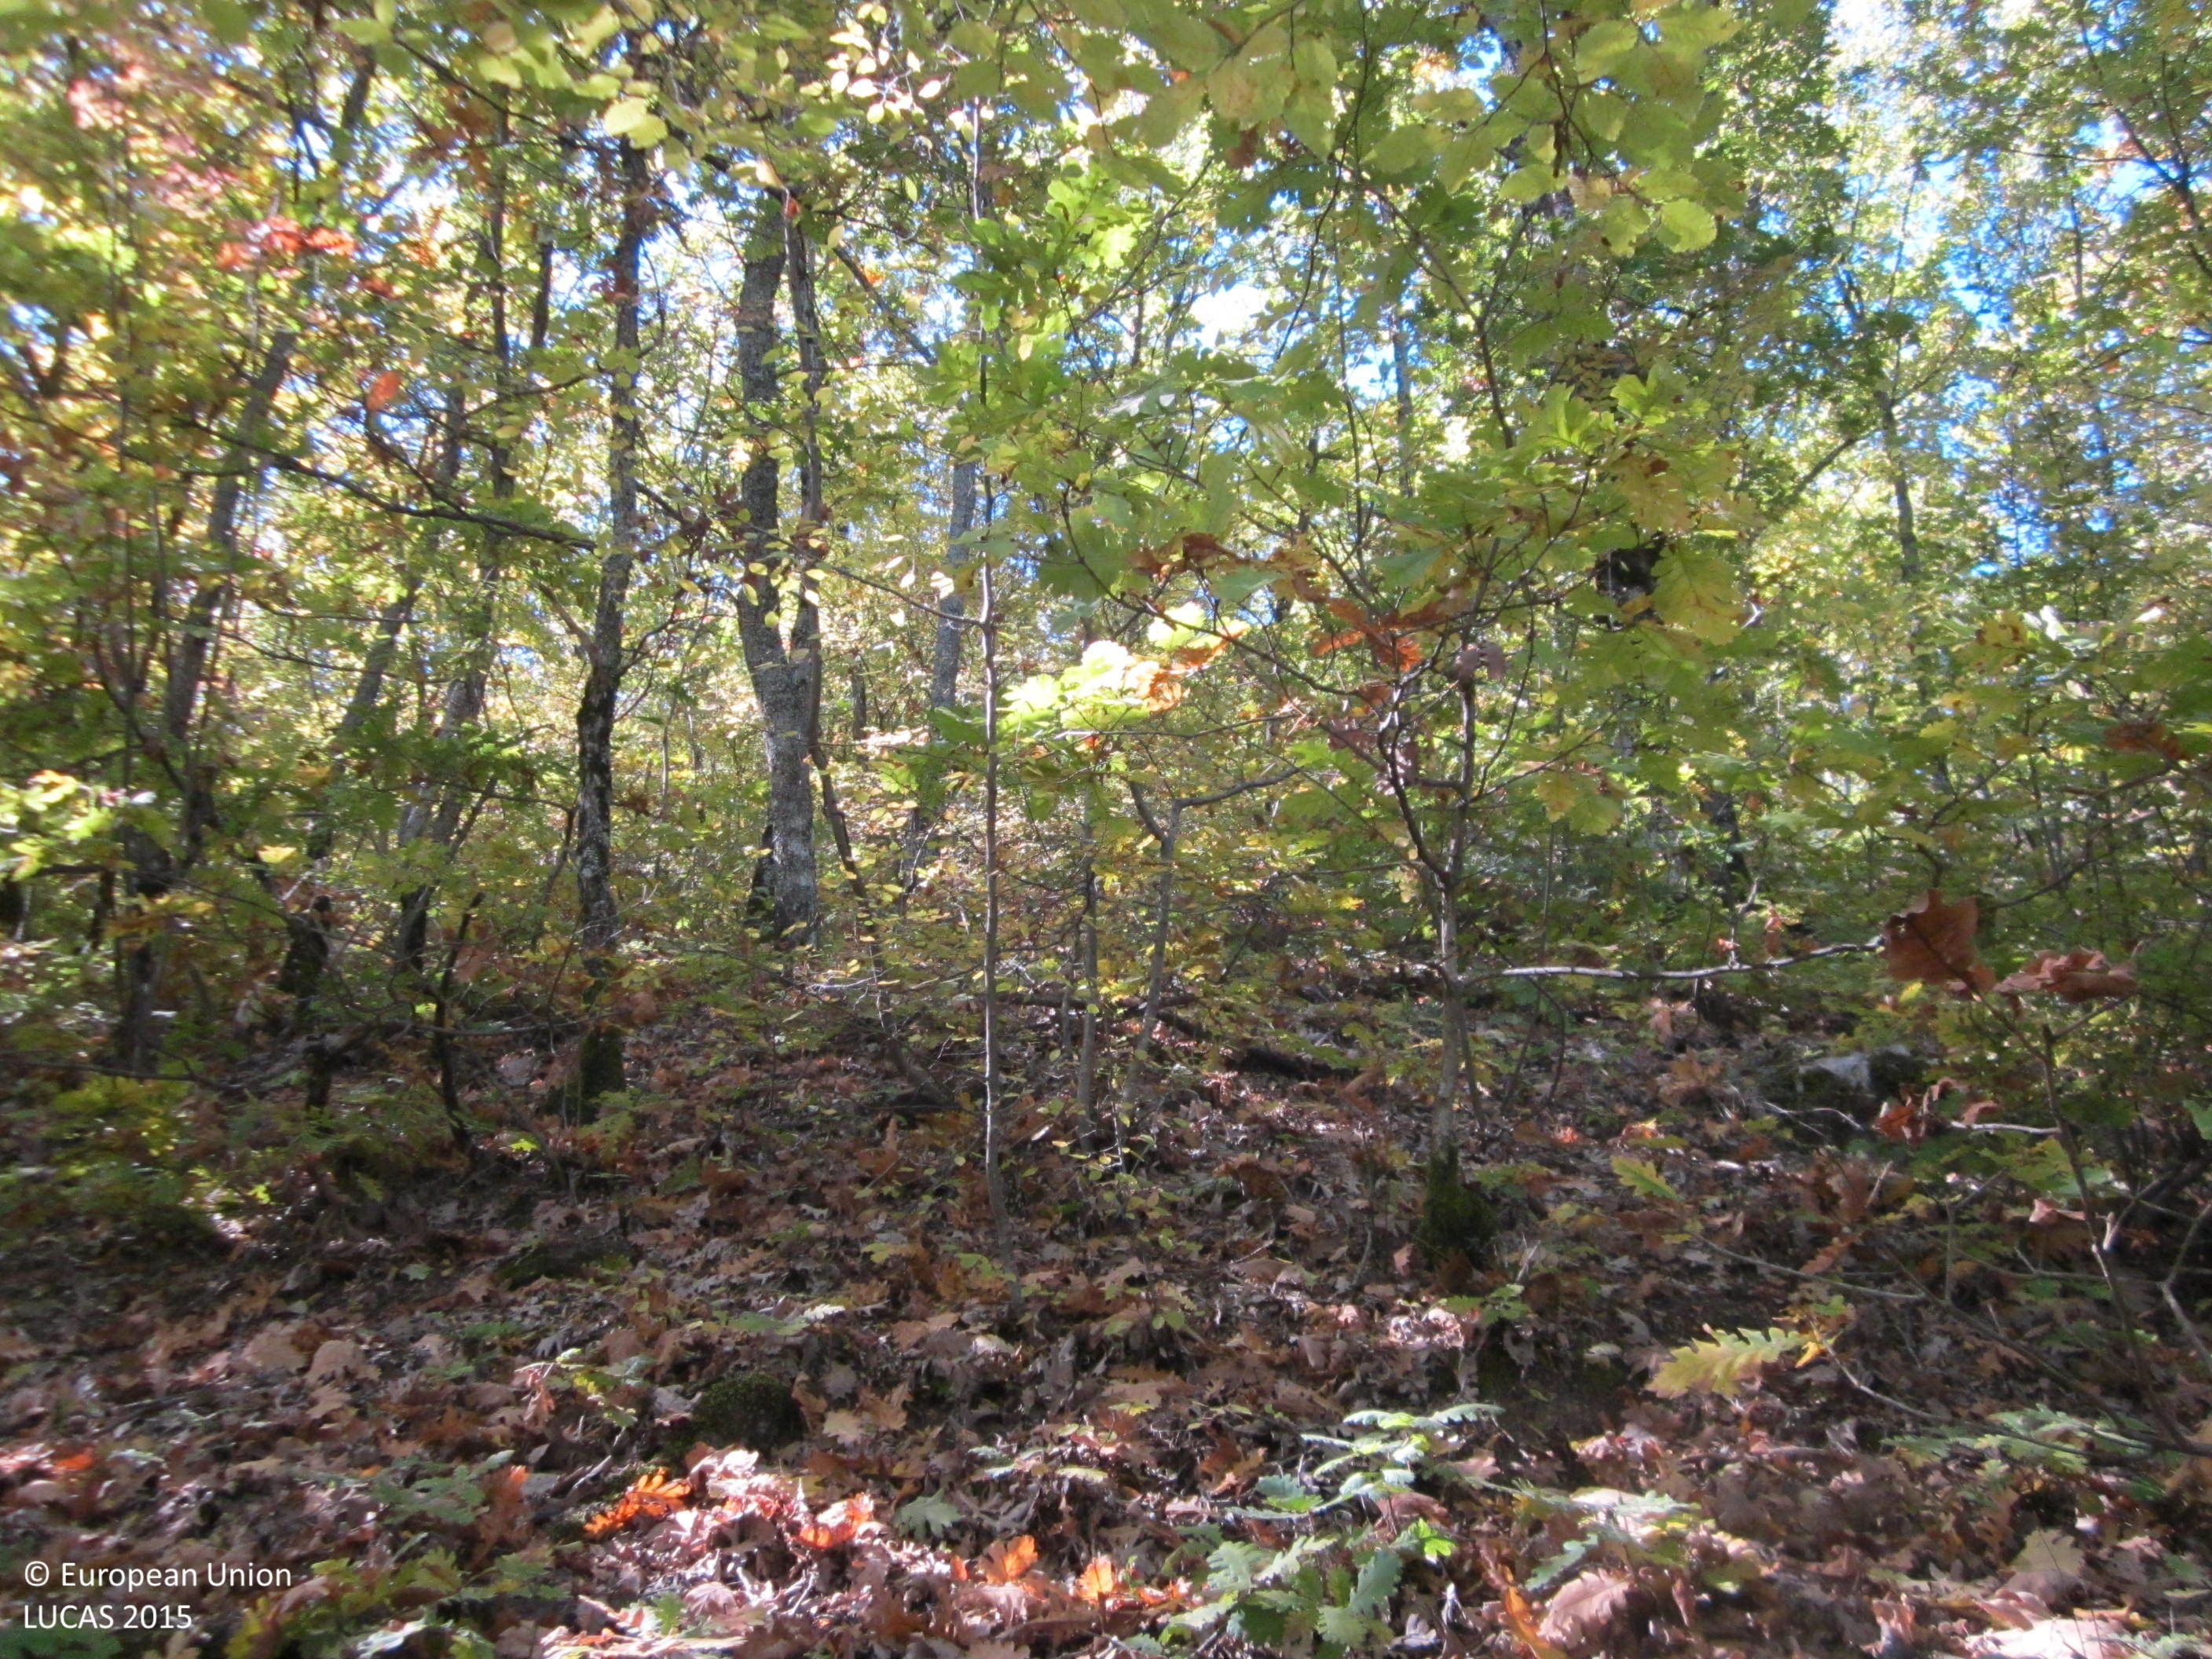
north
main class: Woodland
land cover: Broadleaved woodland
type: thermophilous deciduous forest
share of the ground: > 75 %
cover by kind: broadleaved forest trees 95 %, shrubs 5 %
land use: Forestry
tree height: > 5 m
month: November
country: BG
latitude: 41.4274
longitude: 25.7736
